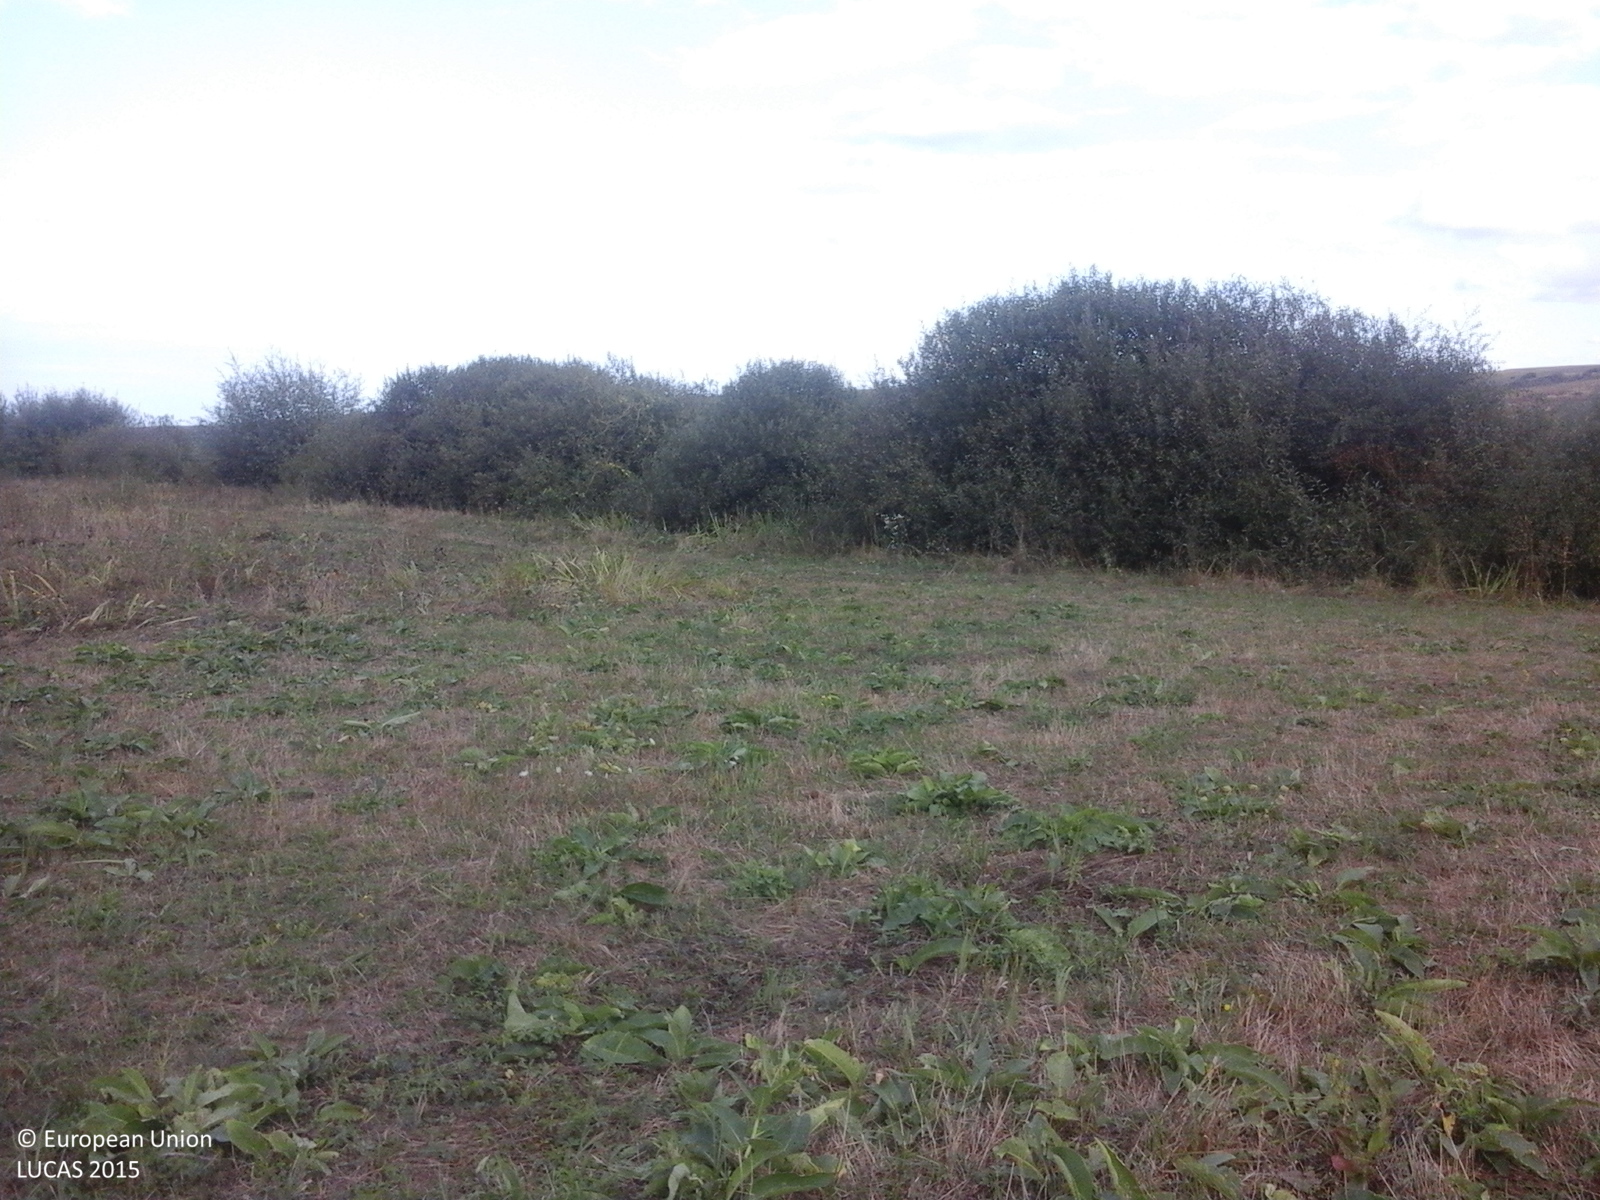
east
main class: Grassland
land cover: Grassland without tree/shrub cover
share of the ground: > 75 %
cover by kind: herbaceous plants 100 %
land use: Agriculture (excluding fallow land and kitchen gardens)
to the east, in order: Grassland without tree/shrub cover; Abandoned hedges; Ditches and canals; Abandoned hedges; Spontaneously vegetated surfaces; Grassland without tree/shrub cover; Spontaneously vegetated surfaces; Grassland without tree/shrub cover; Shrubland without tree cover; Inland fresh water bodies; Shrubland without tree cover
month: September
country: RO
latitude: 47.4635
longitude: 23.1882
